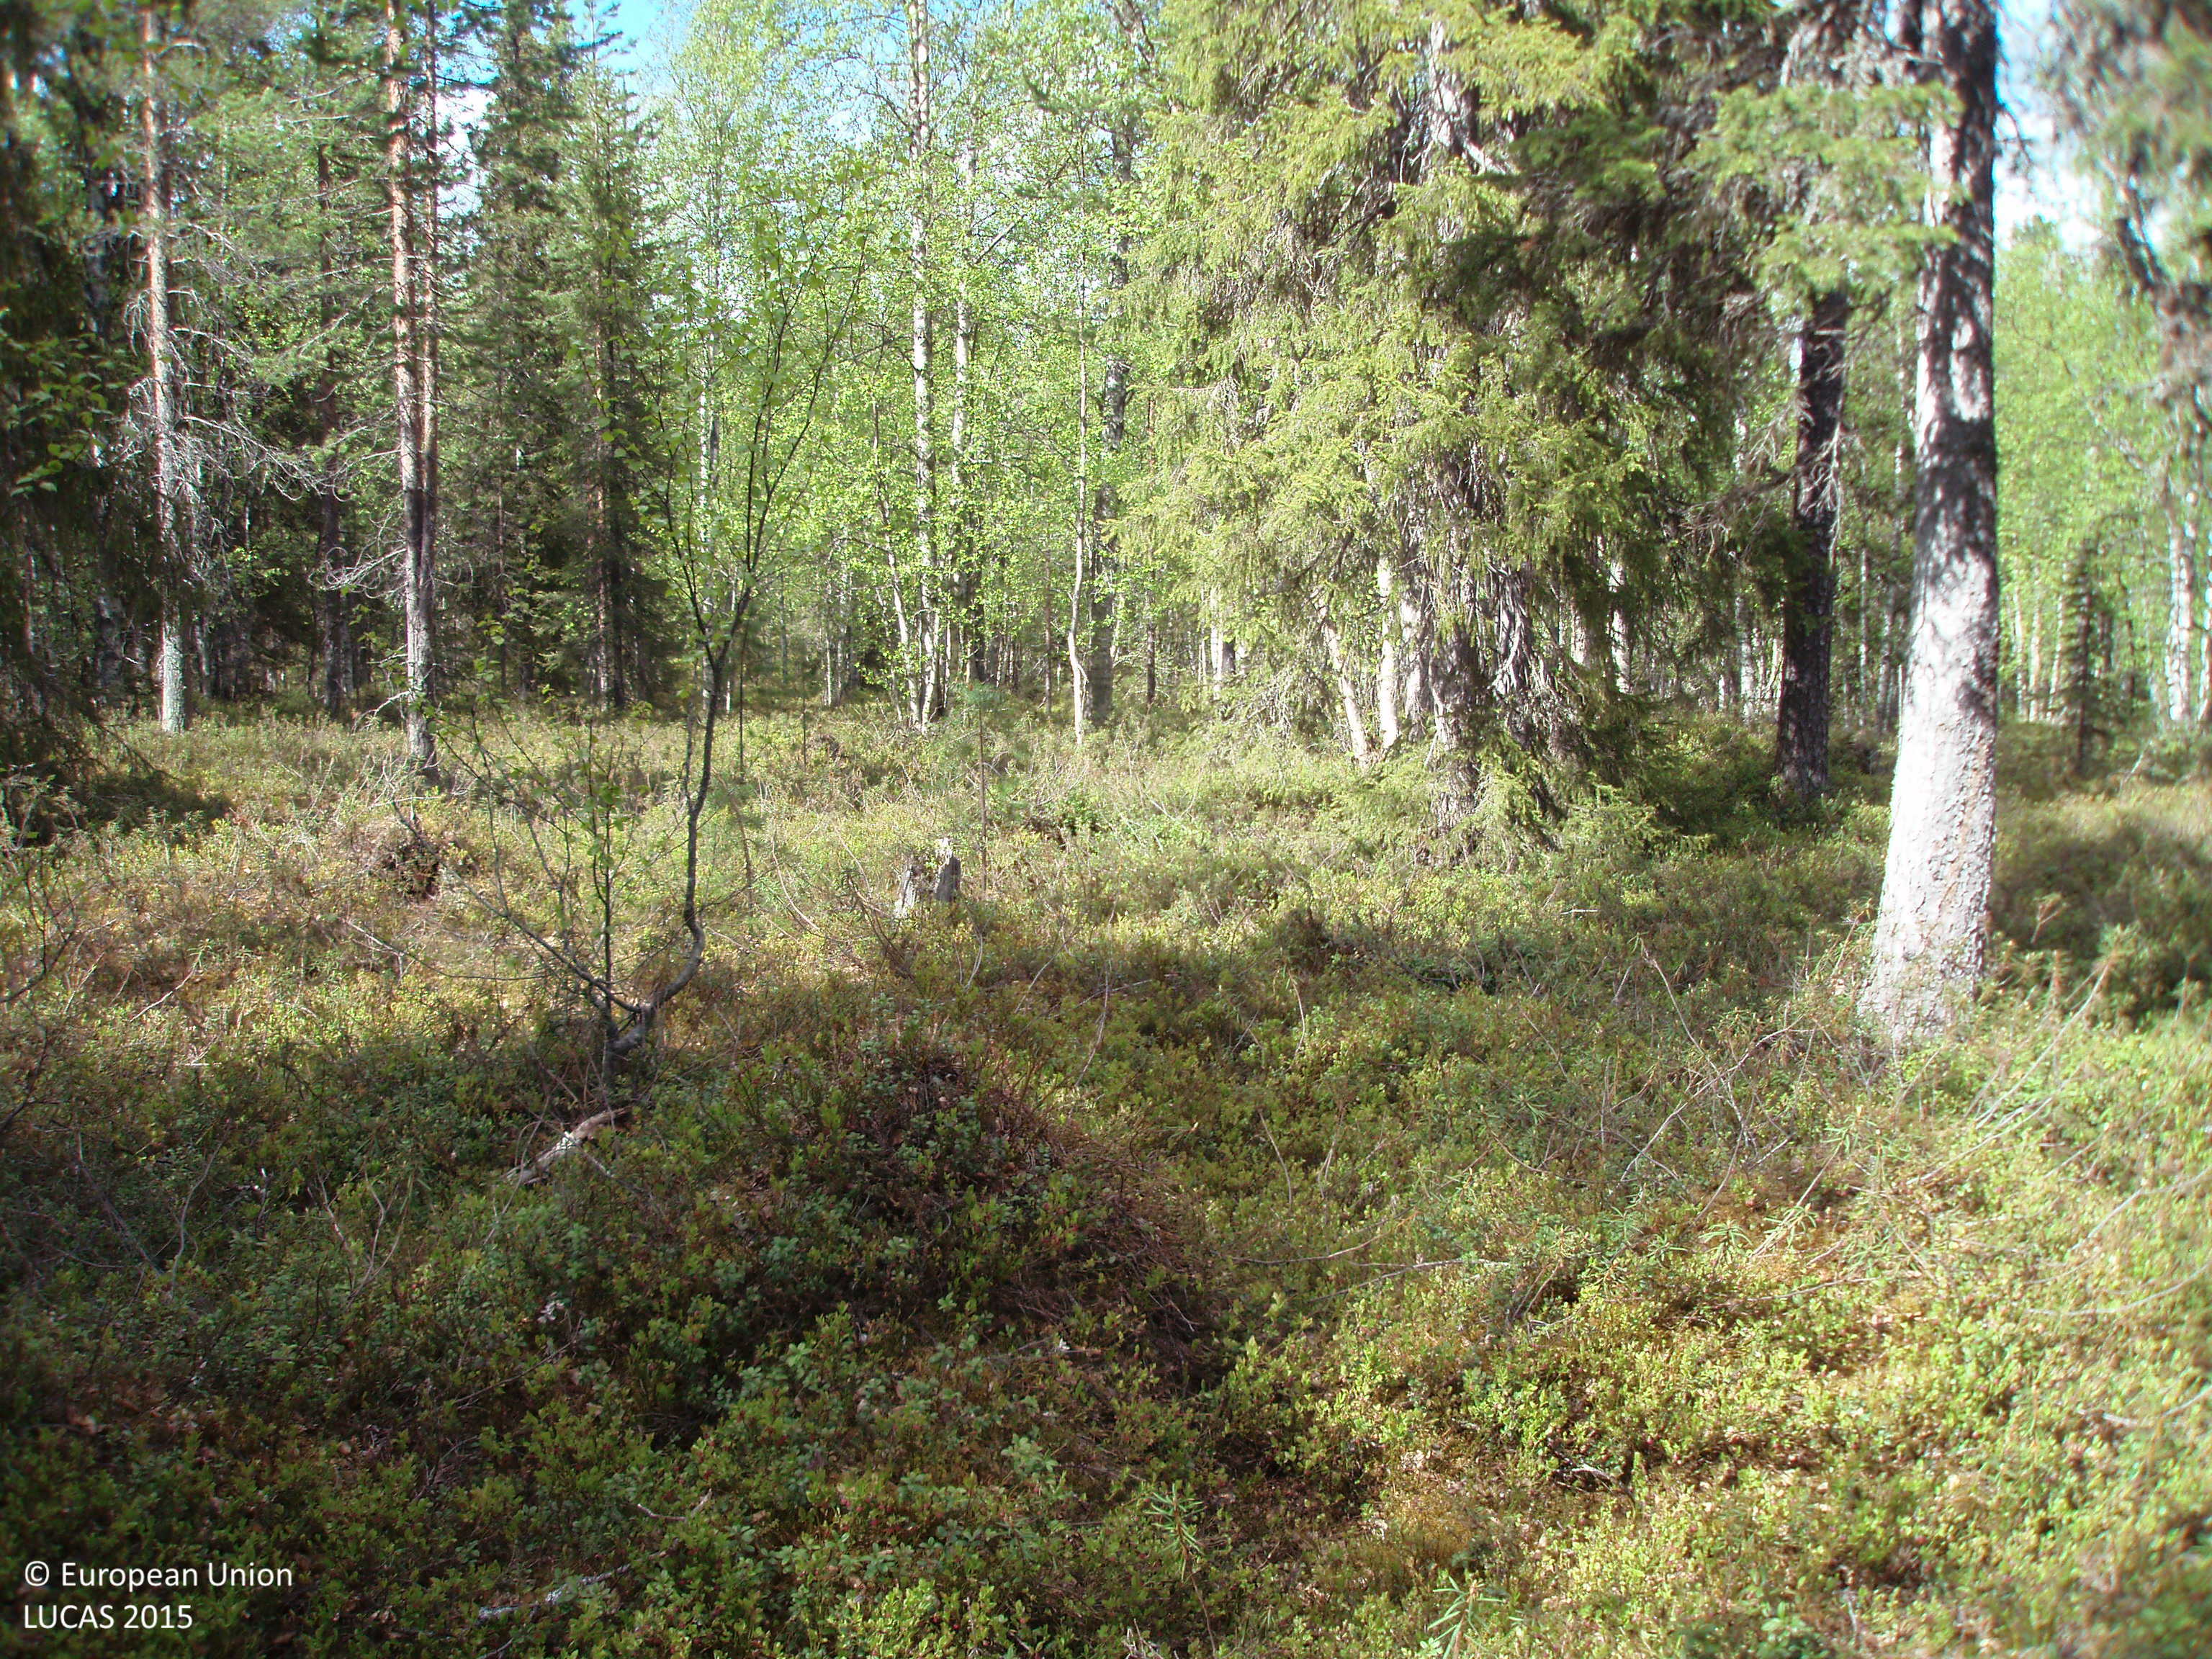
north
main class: Woodland
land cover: Other mixed woodland
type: boreal forest
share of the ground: 50 - 75 %
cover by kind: coniferous forest trees 40 %, broadleaved forest trees 30 %, shrubs 30 %
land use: Forestry
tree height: > 5 m
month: June
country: FI
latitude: 67.0409
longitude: 27.2124
